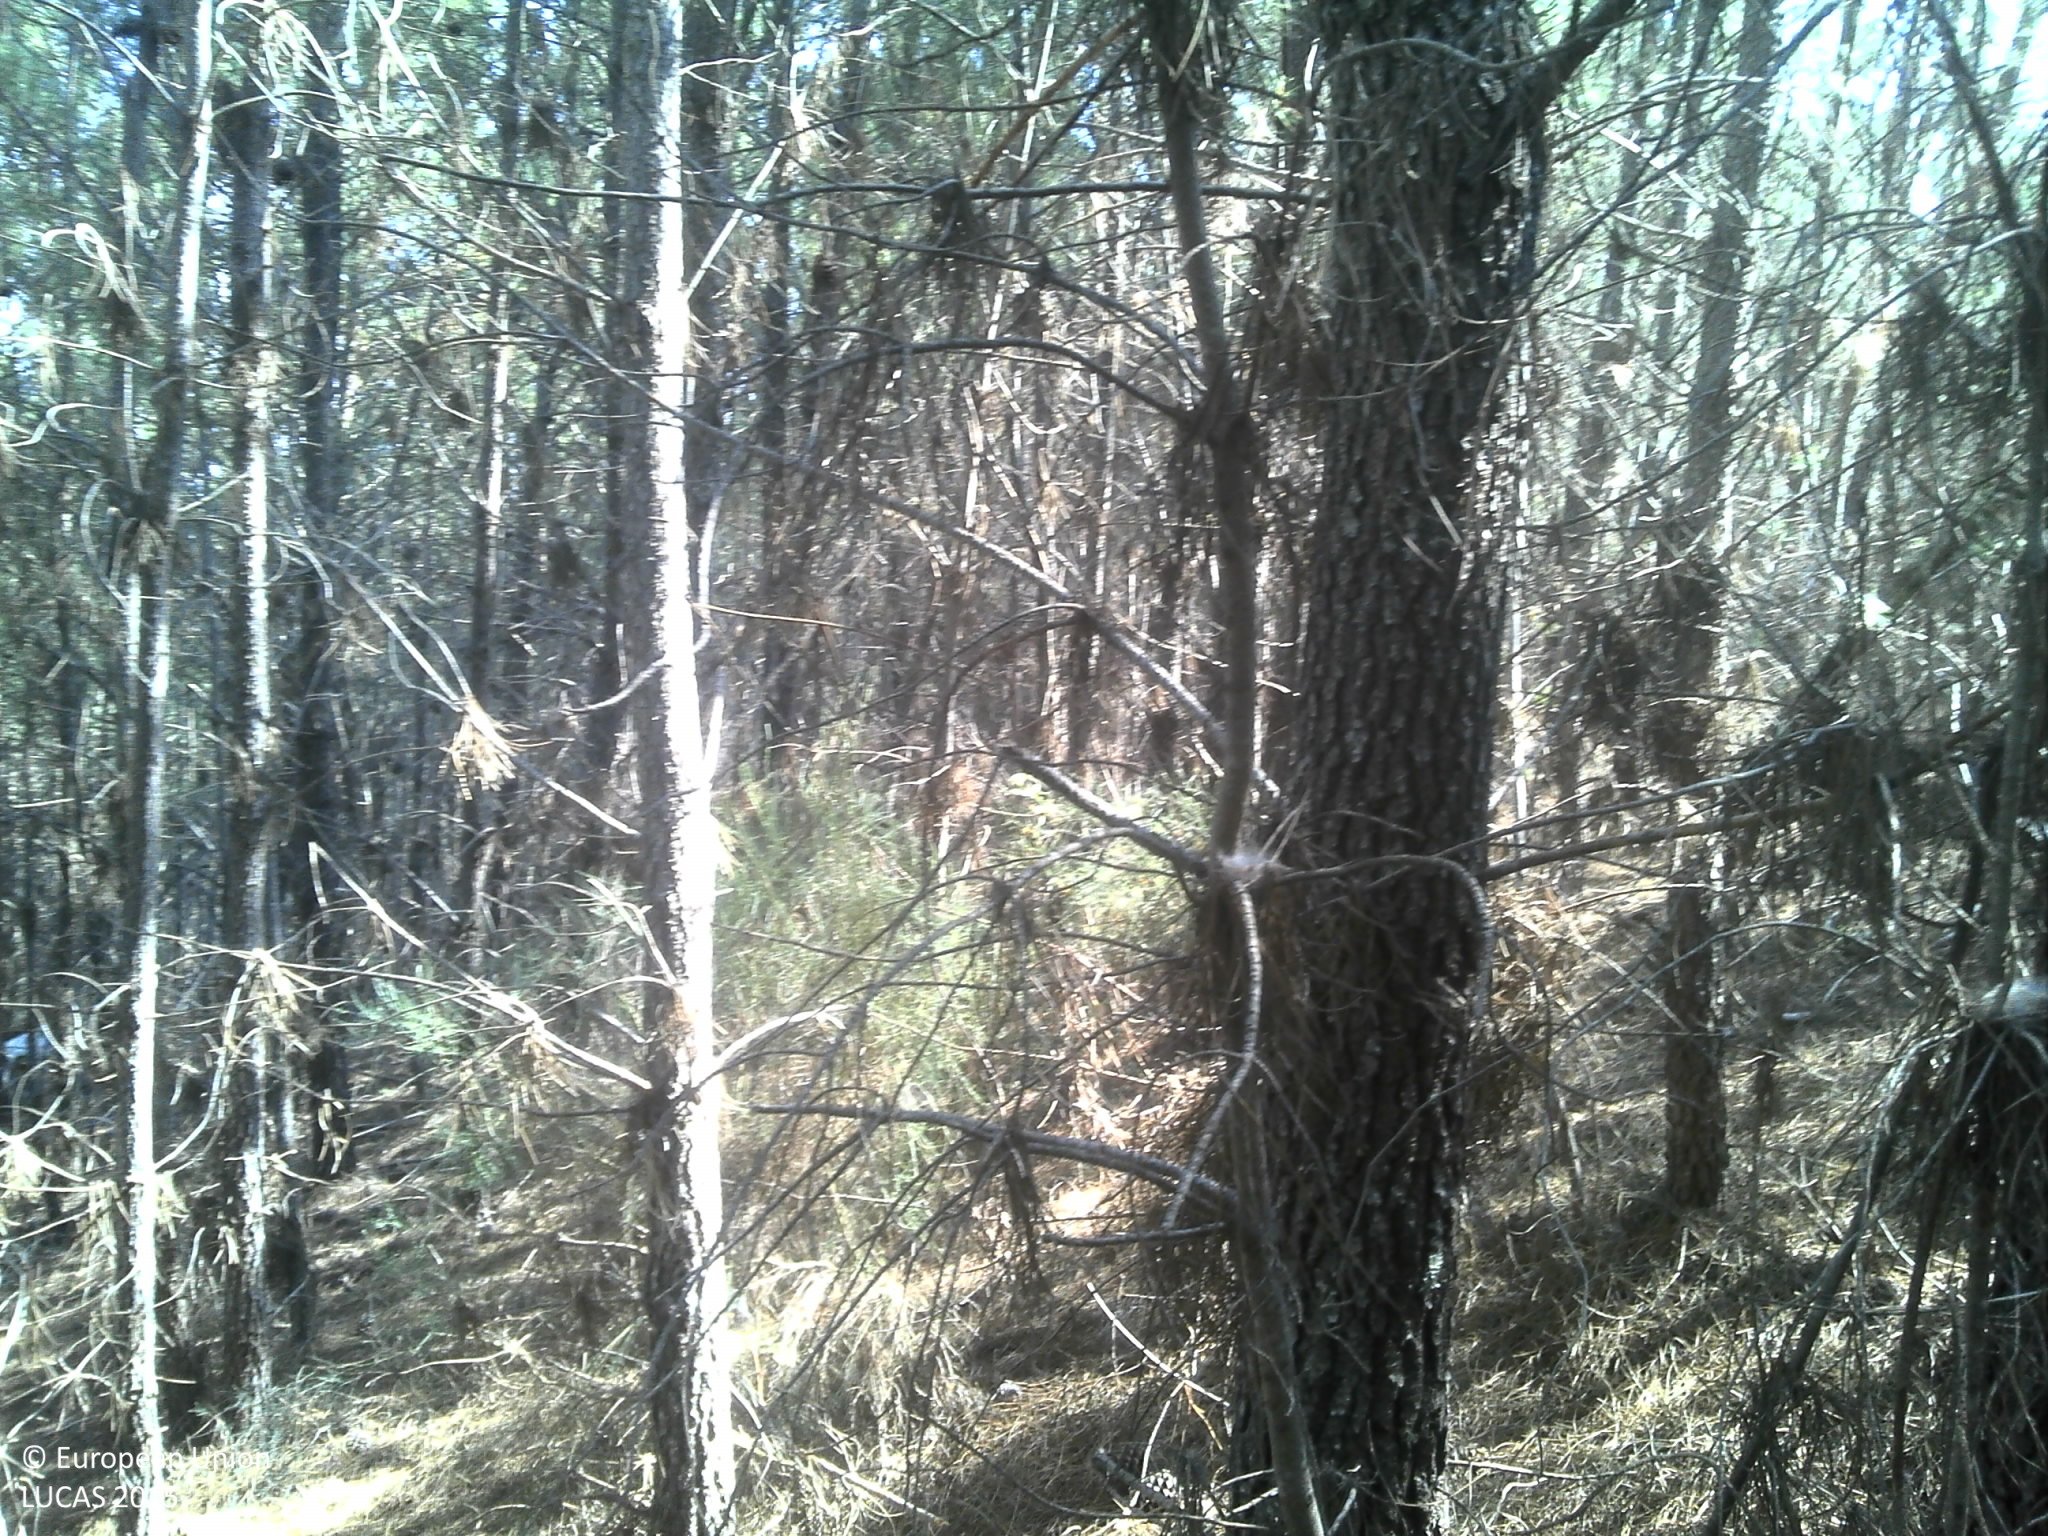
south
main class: Woodland
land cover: Pine dominated coniferous woodland
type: coniferous forest of the mediterranean region
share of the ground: > 75 %
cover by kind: coniferous forest trees 75 %, shrubs 15 %, unconsolidated bare surface 5 %
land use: Forestry
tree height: > 5 m
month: June
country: PT
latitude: 40.2987
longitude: -7.1218
